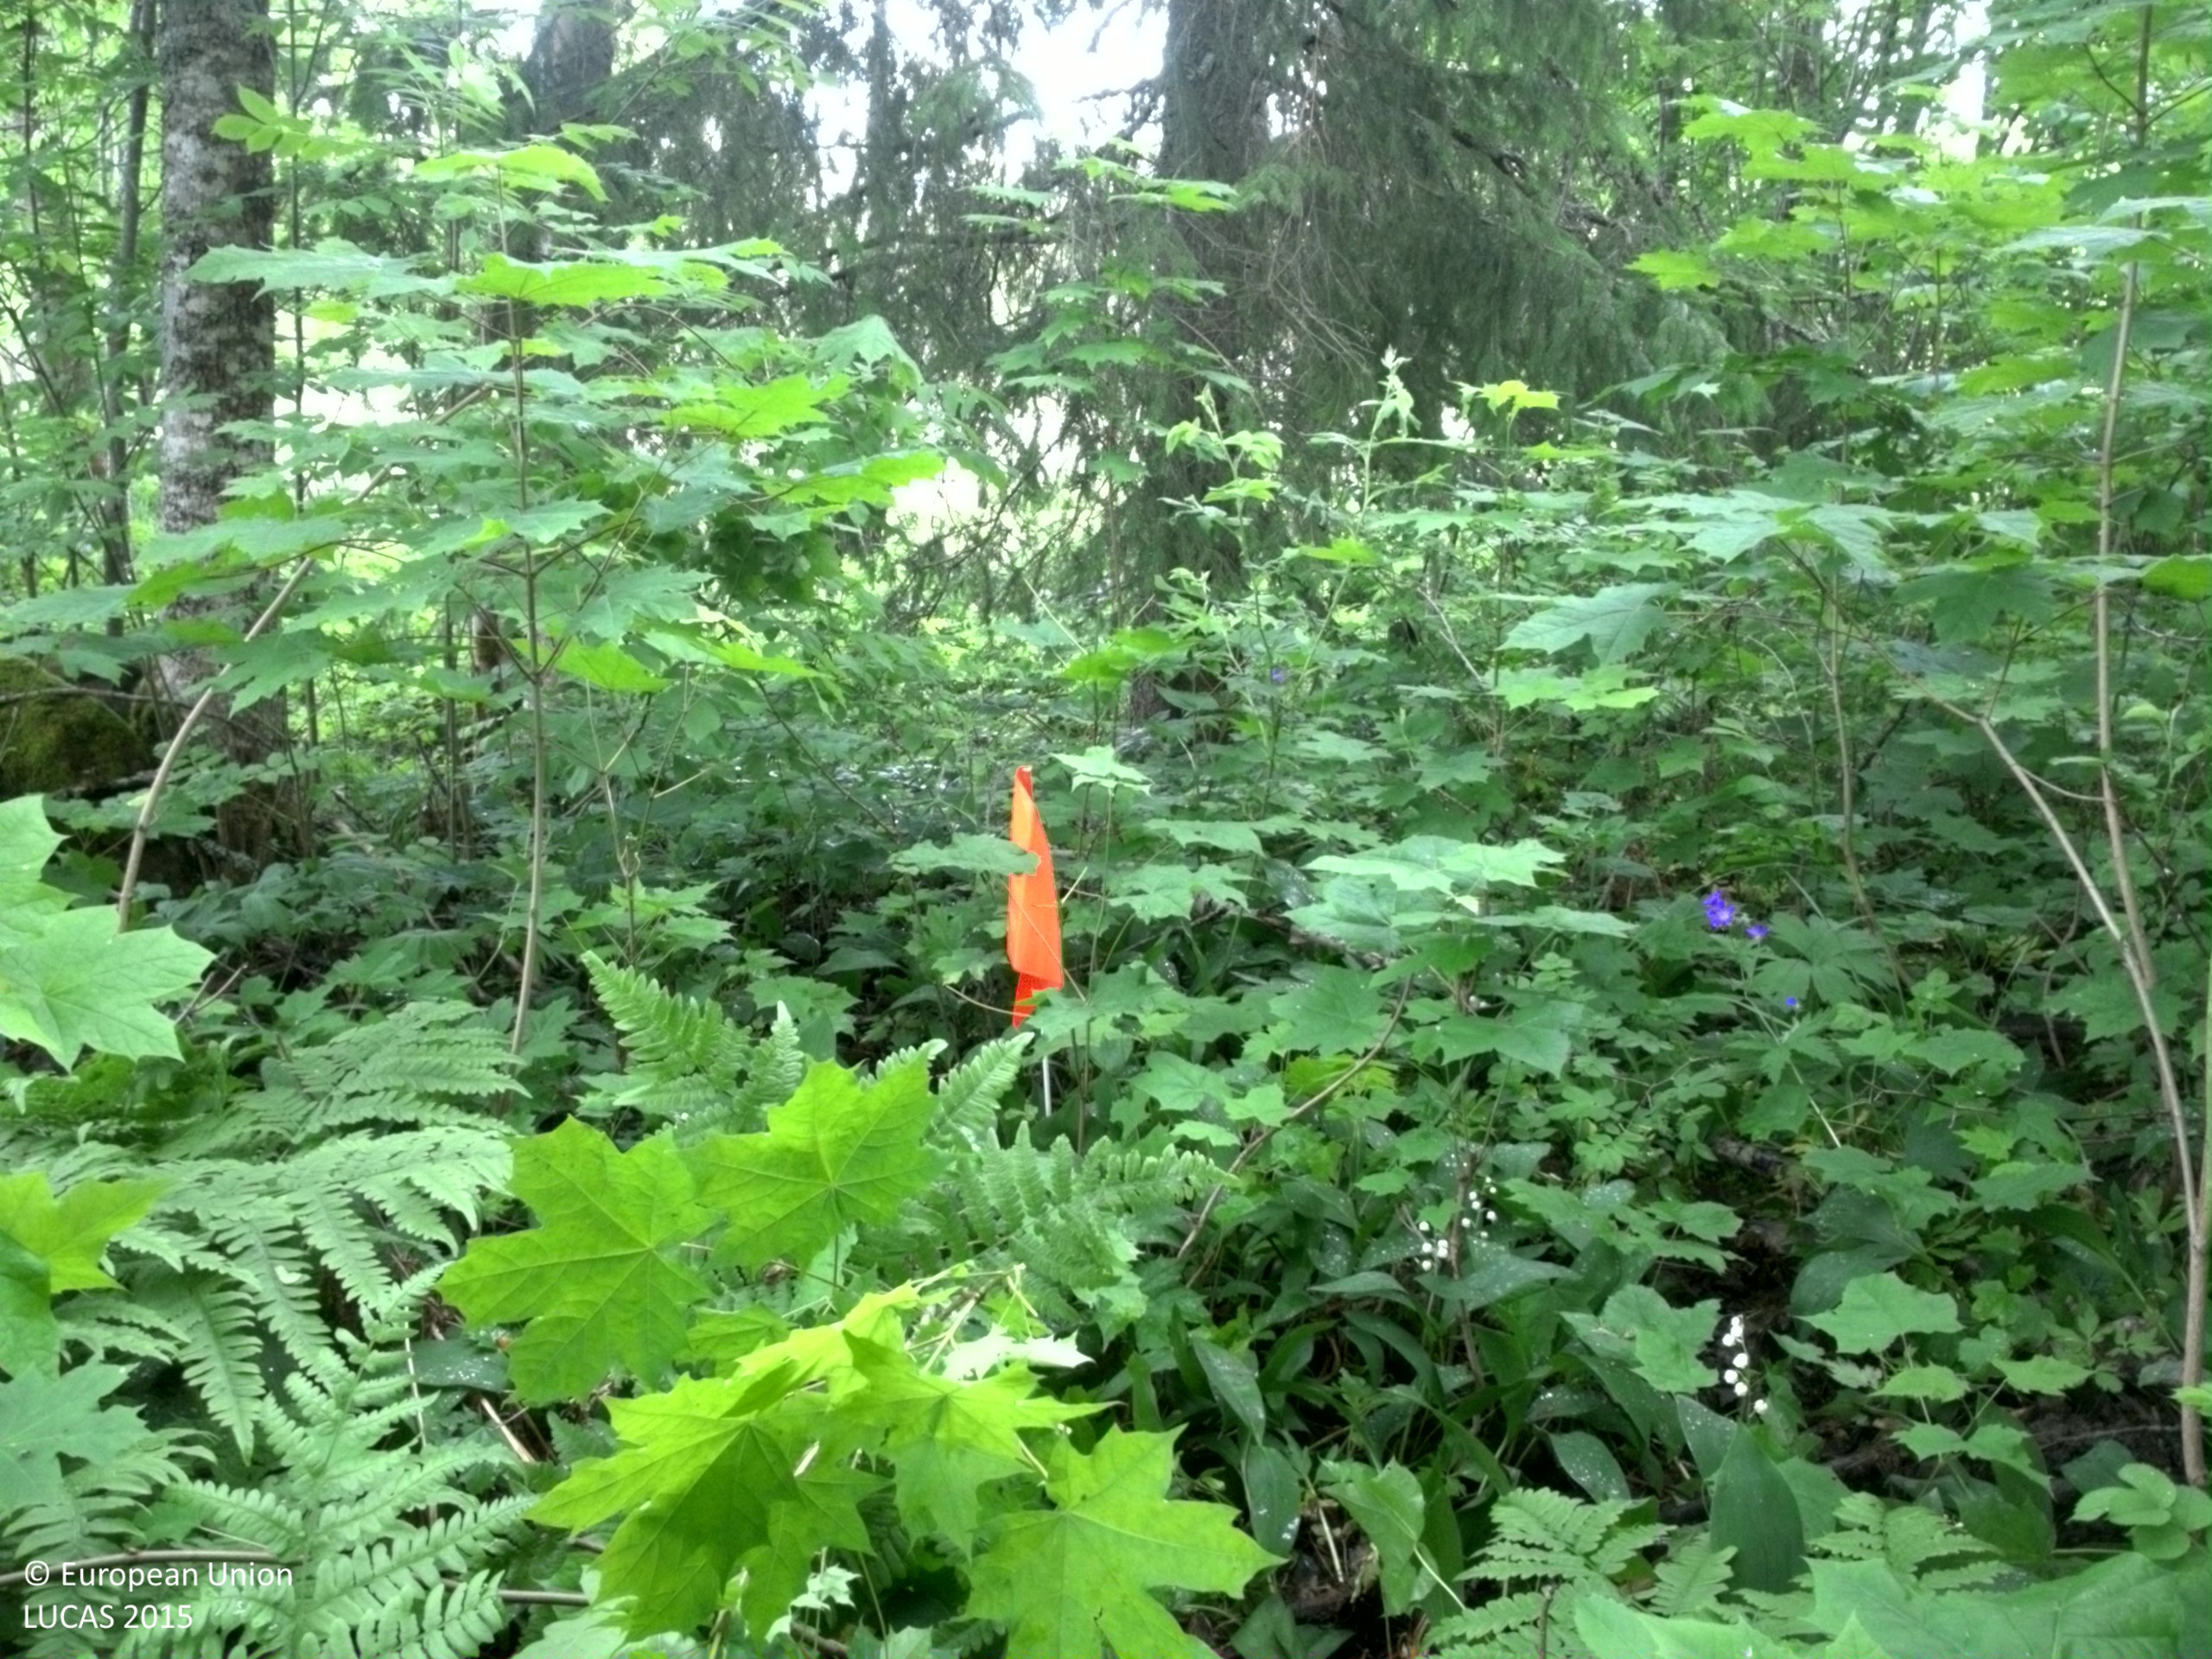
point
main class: Woodland
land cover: Spruce dominated mixed woodland
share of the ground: 50 - 75 %
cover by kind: broadleaved forest trees 45 %, coniferous forest trees 25 %, herbaceous plants 25 %, consolidated bare surface 5 %
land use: Semi-natural and natural areas not in use
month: June
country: SE
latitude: 60.3922
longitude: 17.5946
